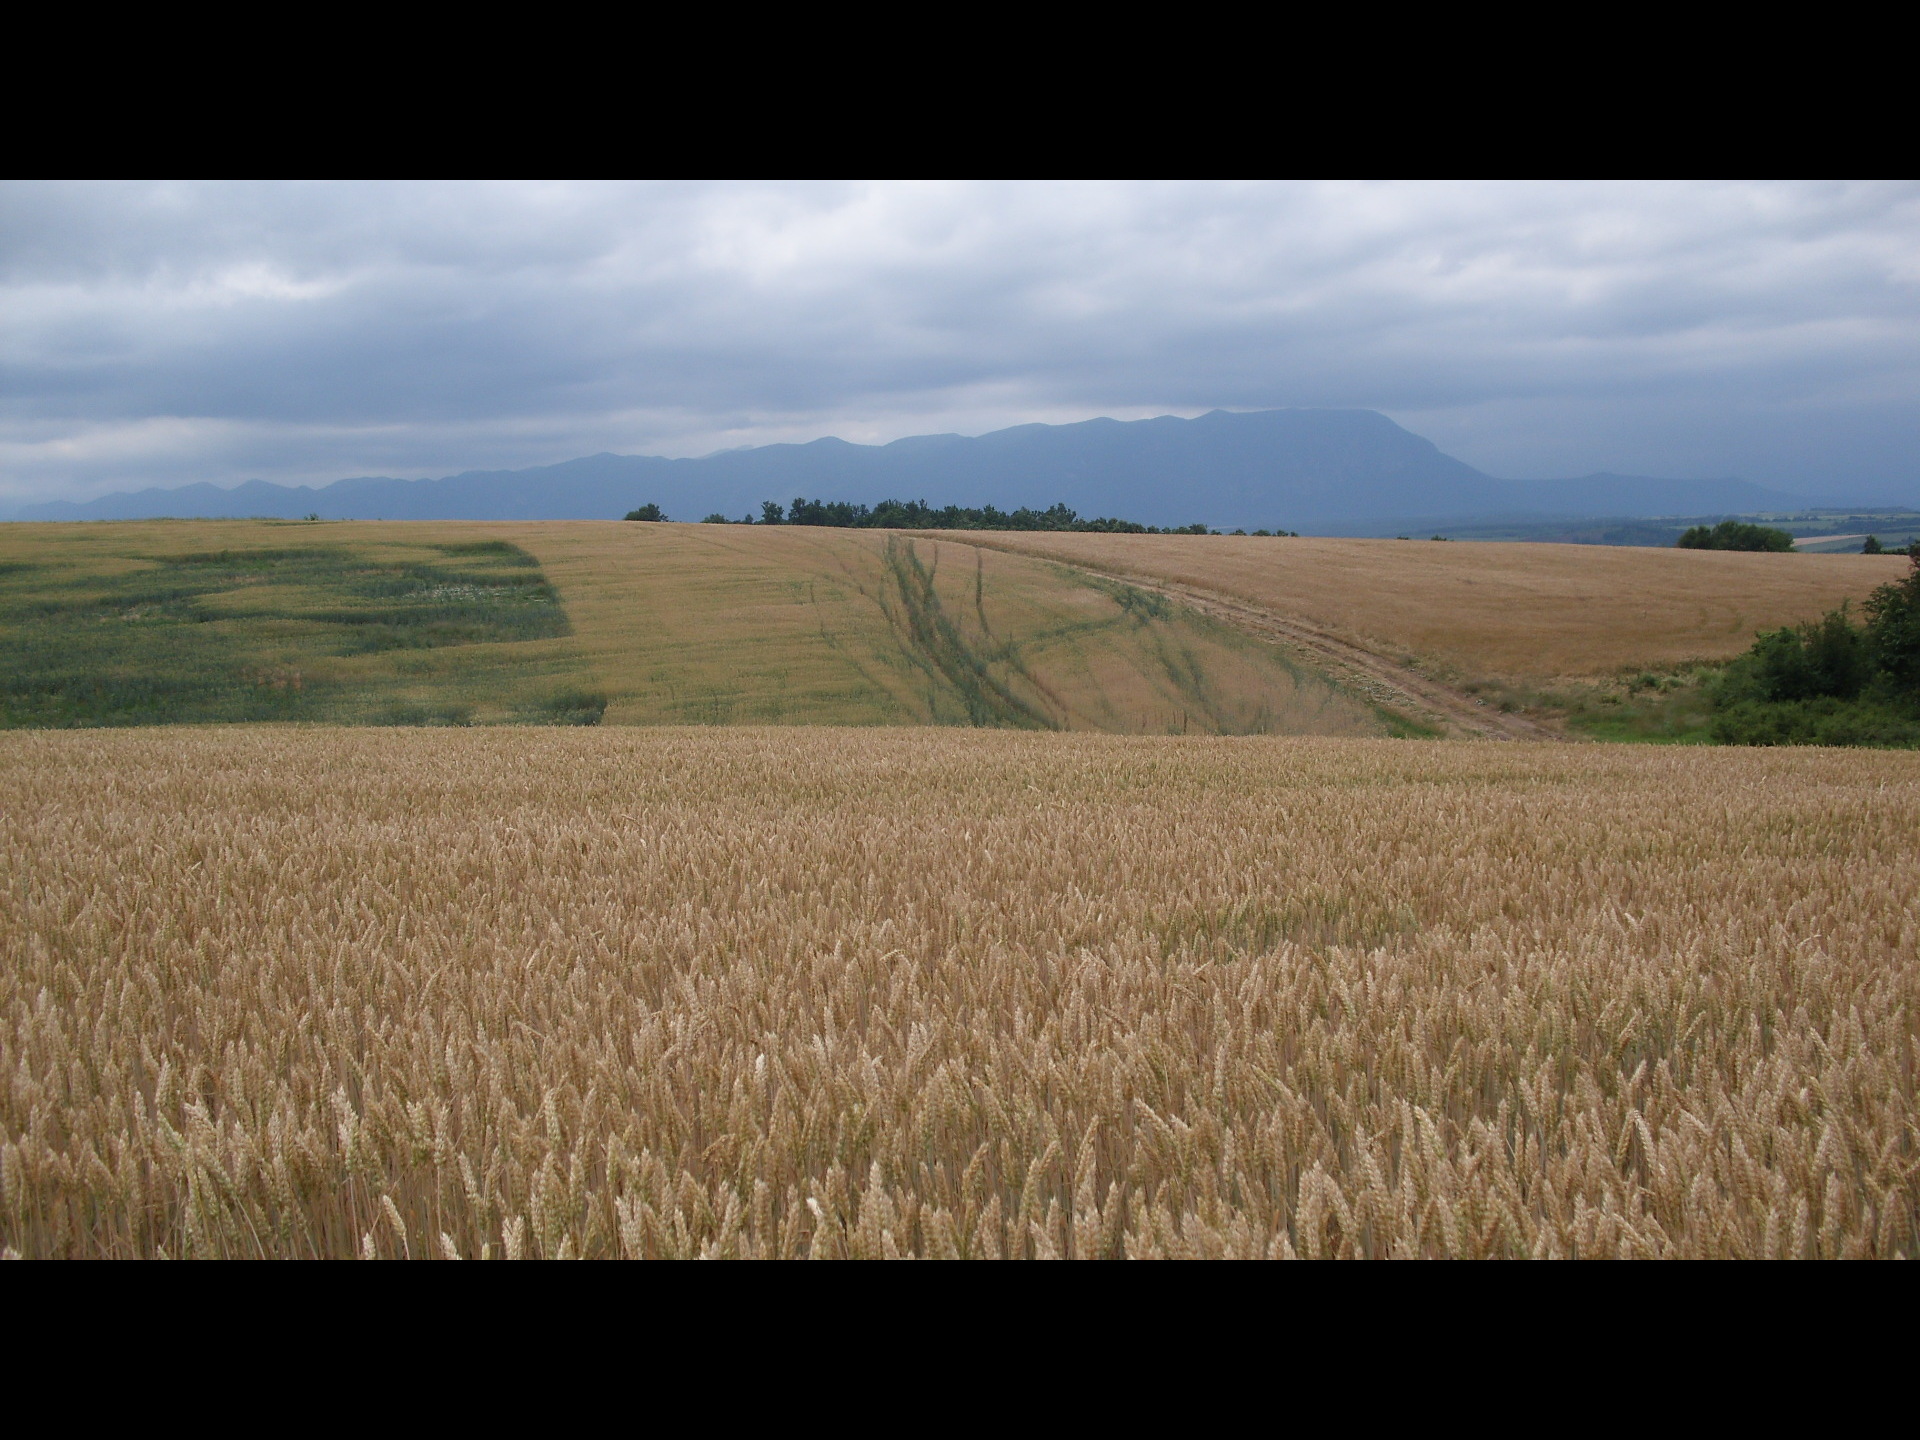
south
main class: Cropland
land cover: Common wheat
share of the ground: > 75 %
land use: Agriculture (excluding fallow land and kitchen gardens)
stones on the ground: < 10 %
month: June
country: BG
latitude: 43.3713
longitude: 23.5079
